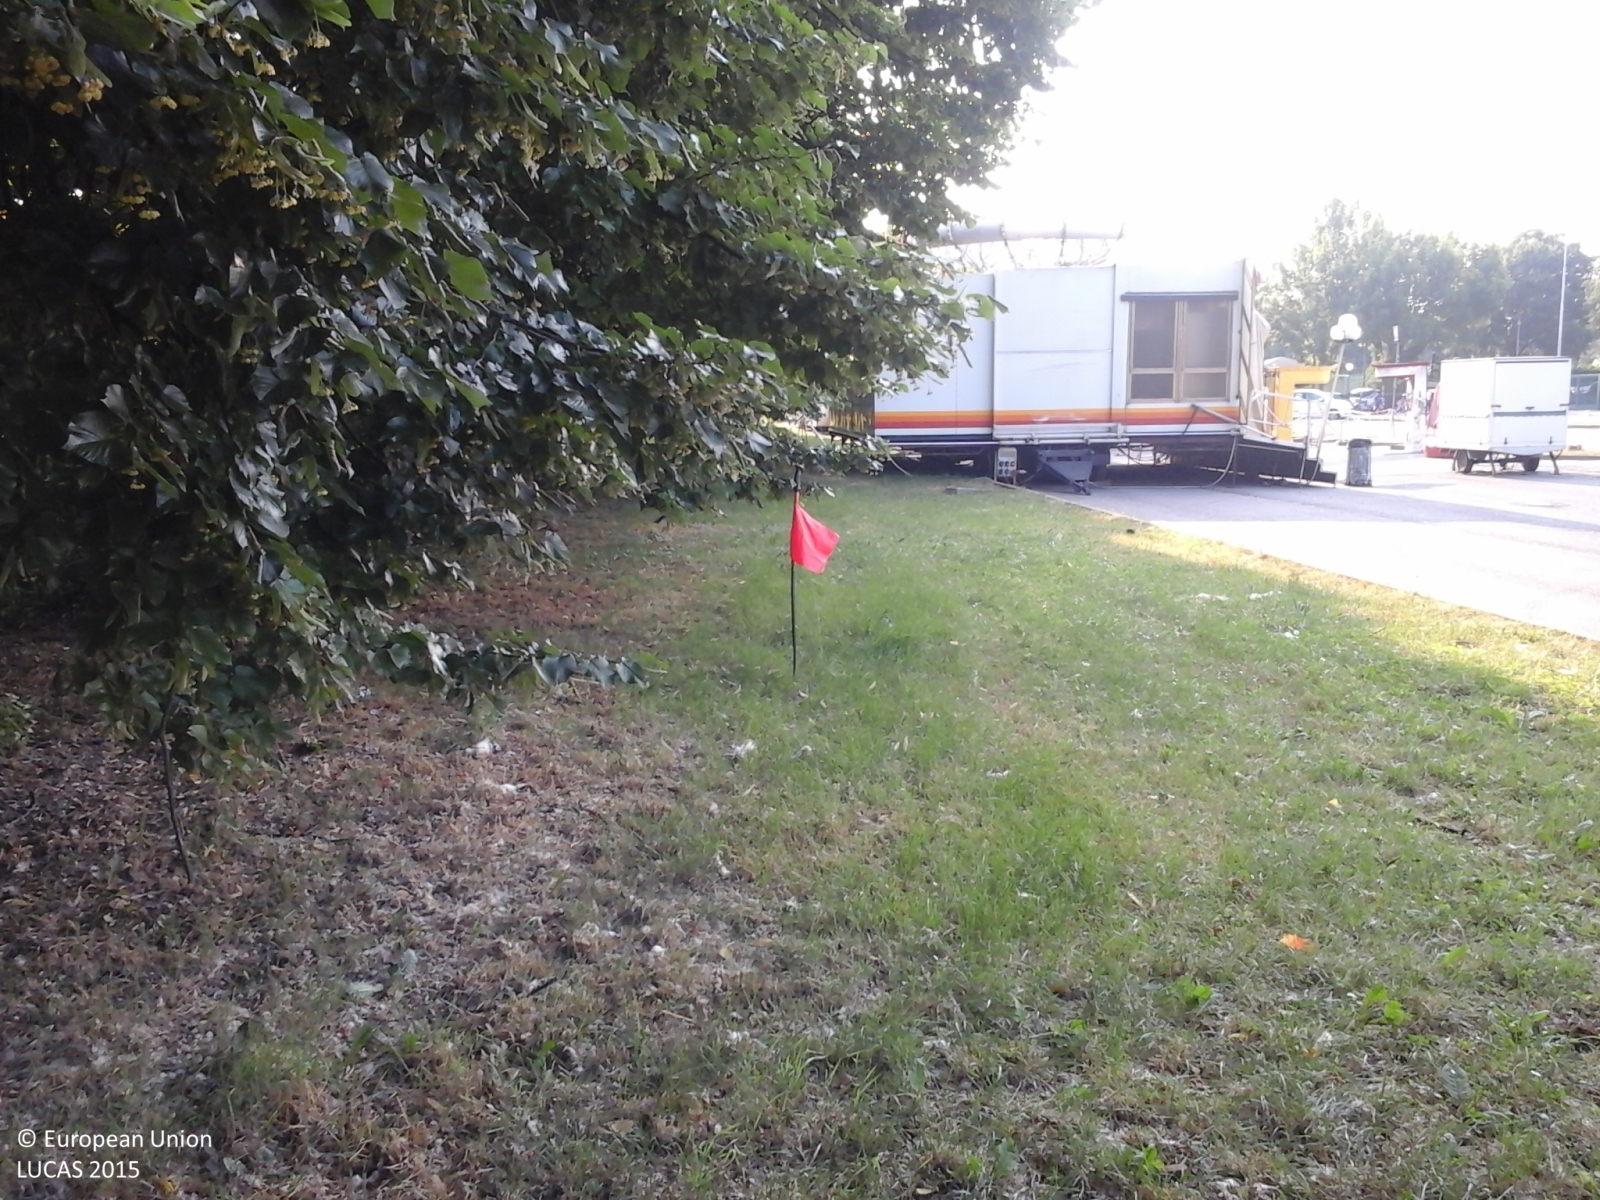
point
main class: Woodland
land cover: Broadleaved woodland
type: mesophytic deciduous forest
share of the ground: > 75 %
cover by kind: herbaceous plants 60 %, broadleaved forest trees 40 %
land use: Community services
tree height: > 5 m
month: June
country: IT
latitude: 45.3959
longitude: 10.2678
